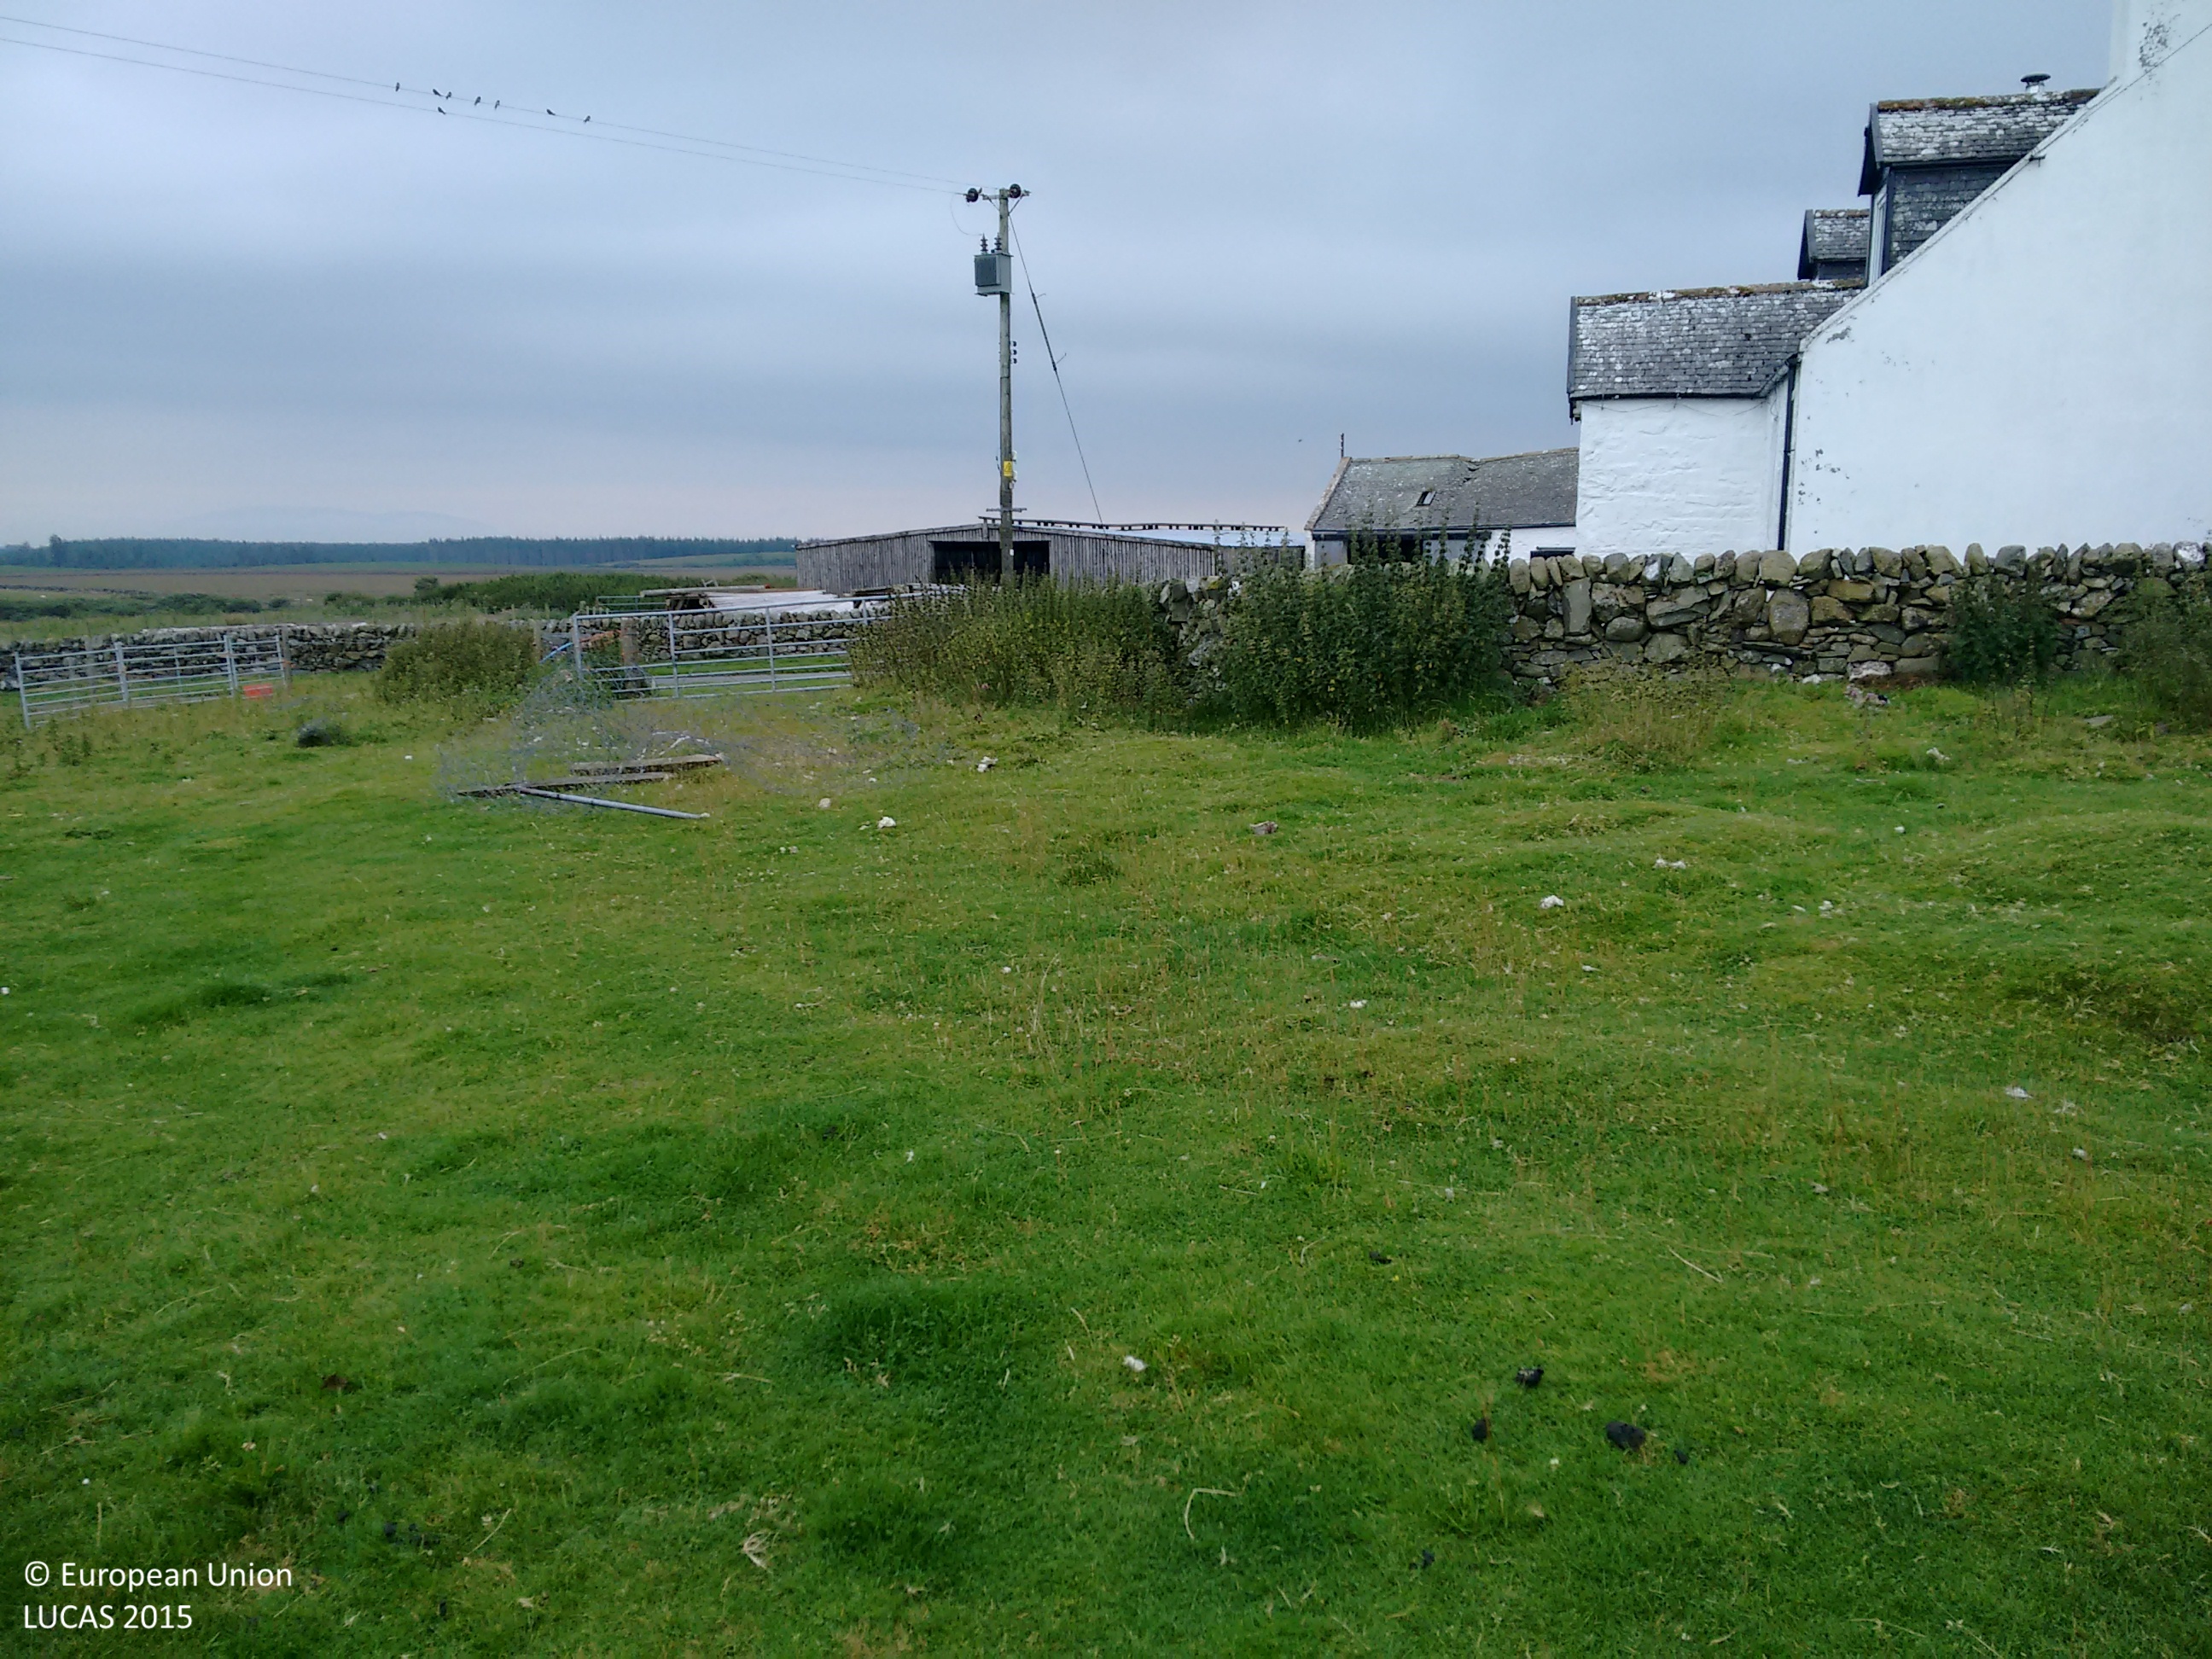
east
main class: Grassland
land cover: Grassland without tree/shrub cover
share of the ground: > 75 %
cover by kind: herbaceous plants 100 %
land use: Agriculture (excluding fallow land and kitchen gardens)
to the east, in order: Grassland without tree/shrub cover; Artificial constructions in urban areas; Grass margins; Grassland without tree/shrub cover; Peatbogs; Shrubland without tree cover; Fences; Peatbogs
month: August
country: GB
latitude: 54.8932
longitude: -4.7163
